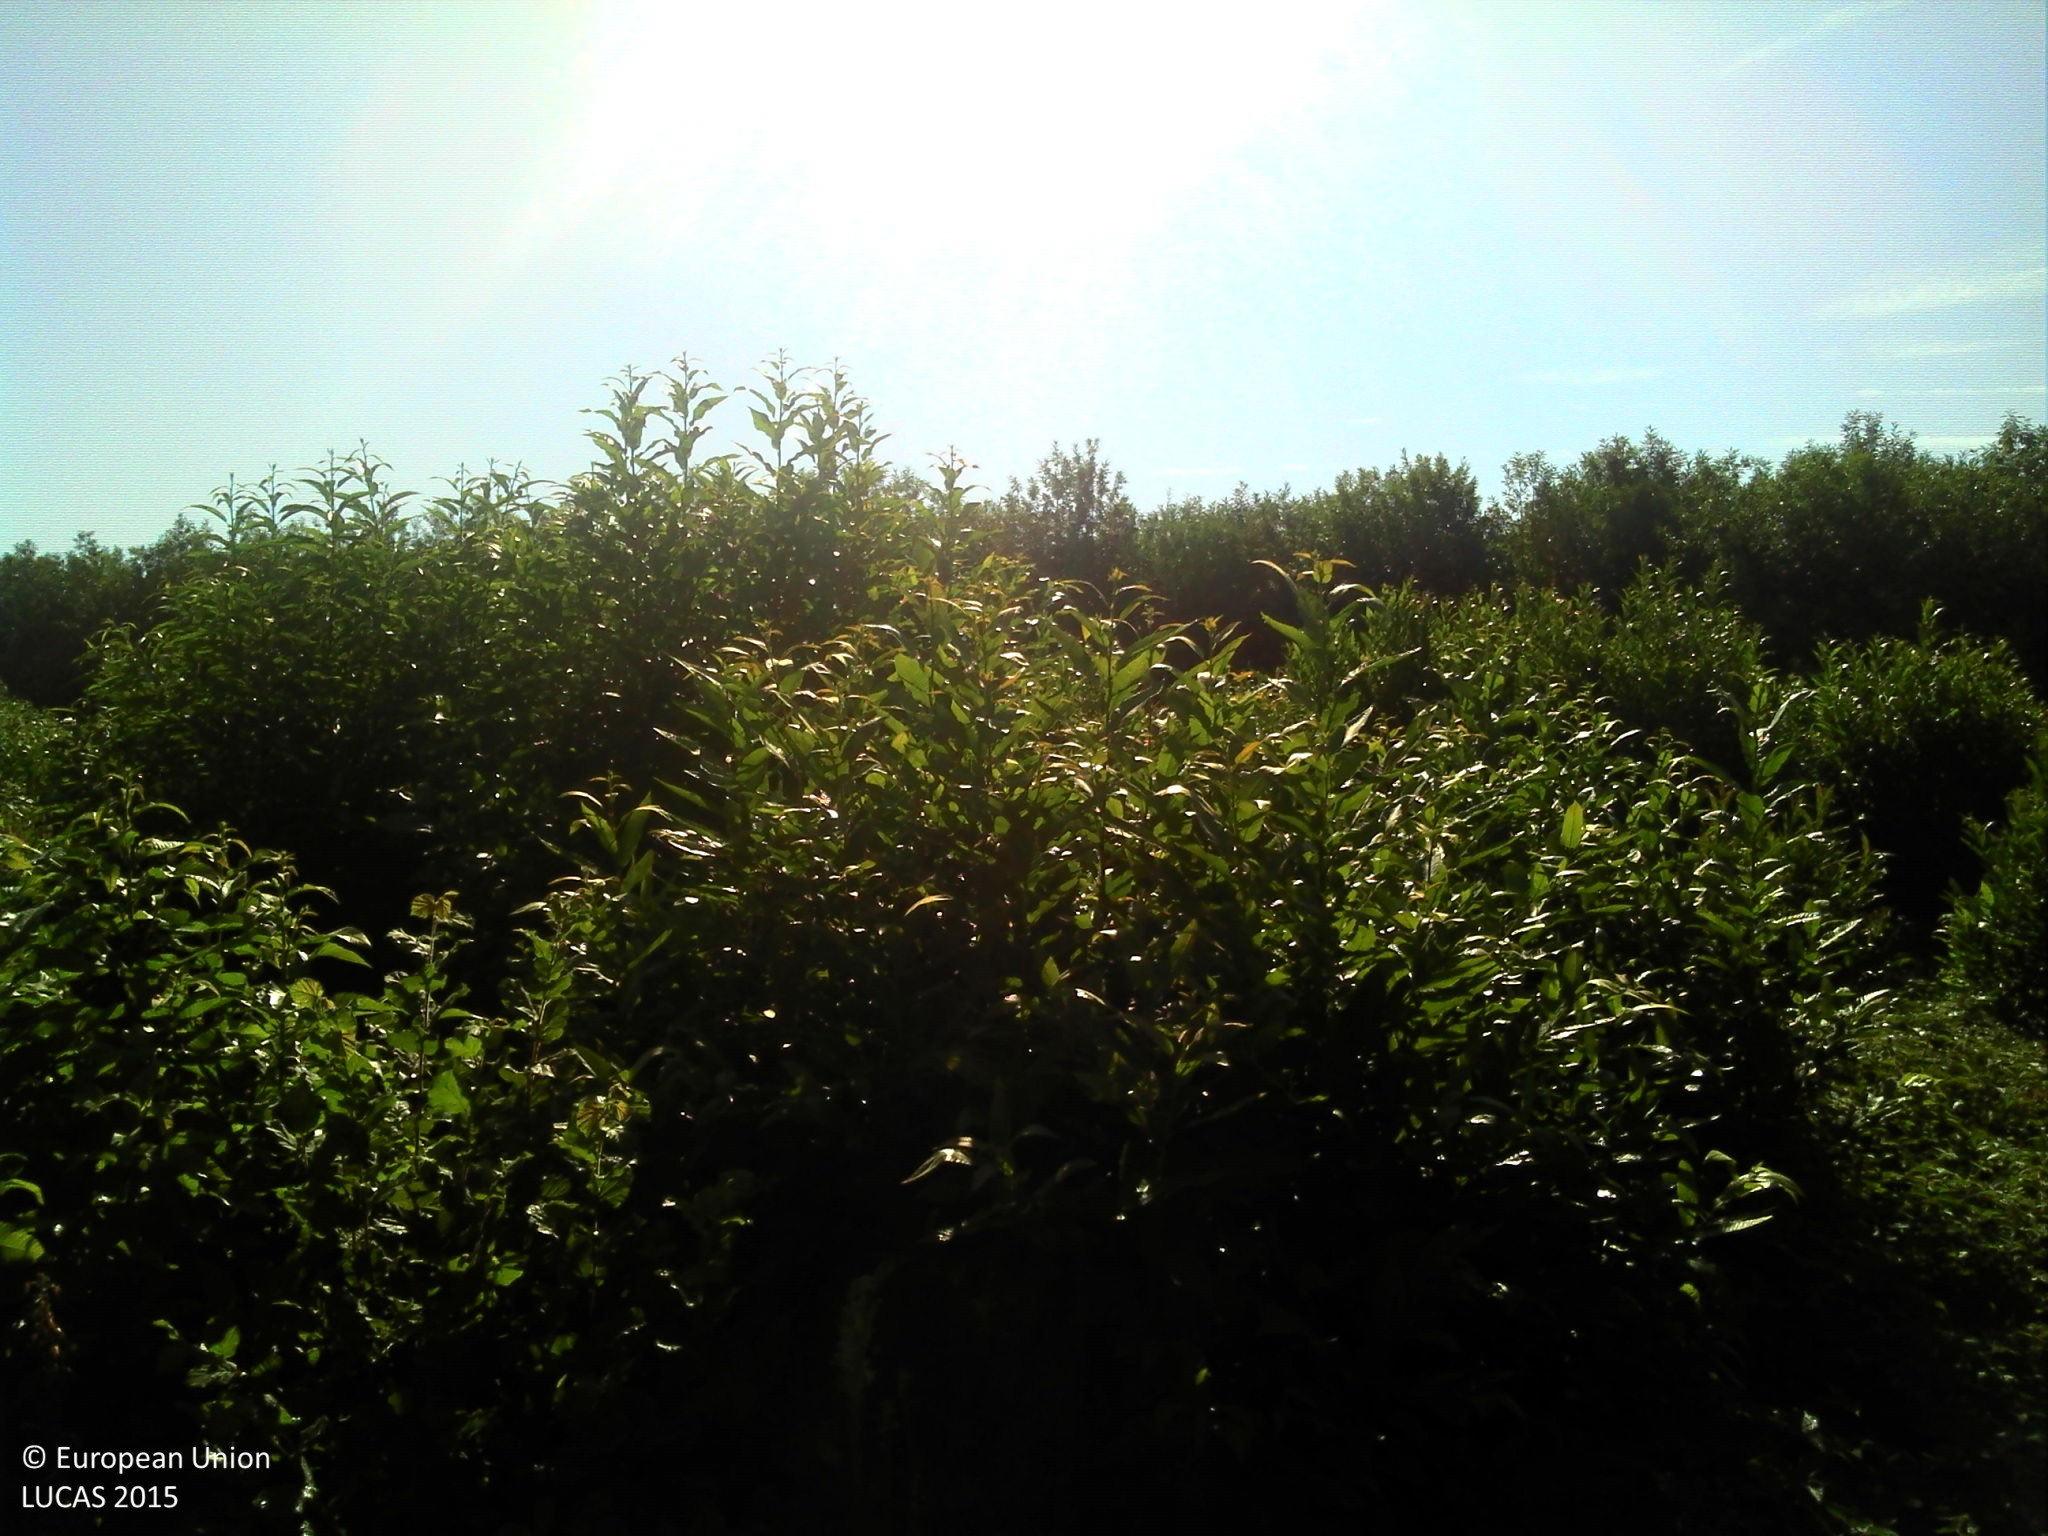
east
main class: Shrubland
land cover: Shrubland with sparse tree cover
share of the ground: > 75 %
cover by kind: shrubs 90 %, broadleaved forest trees 5 %, herbaceous plants 5 %
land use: Forestry
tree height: < 5 m
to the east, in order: Shrubland with sparse tree cover; Broadleaved woodland; Grassland without tree/shrub cover; Shrubland with sparse tree cover; Maize
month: July
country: FR
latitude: 46.1999
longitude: 1.5808
